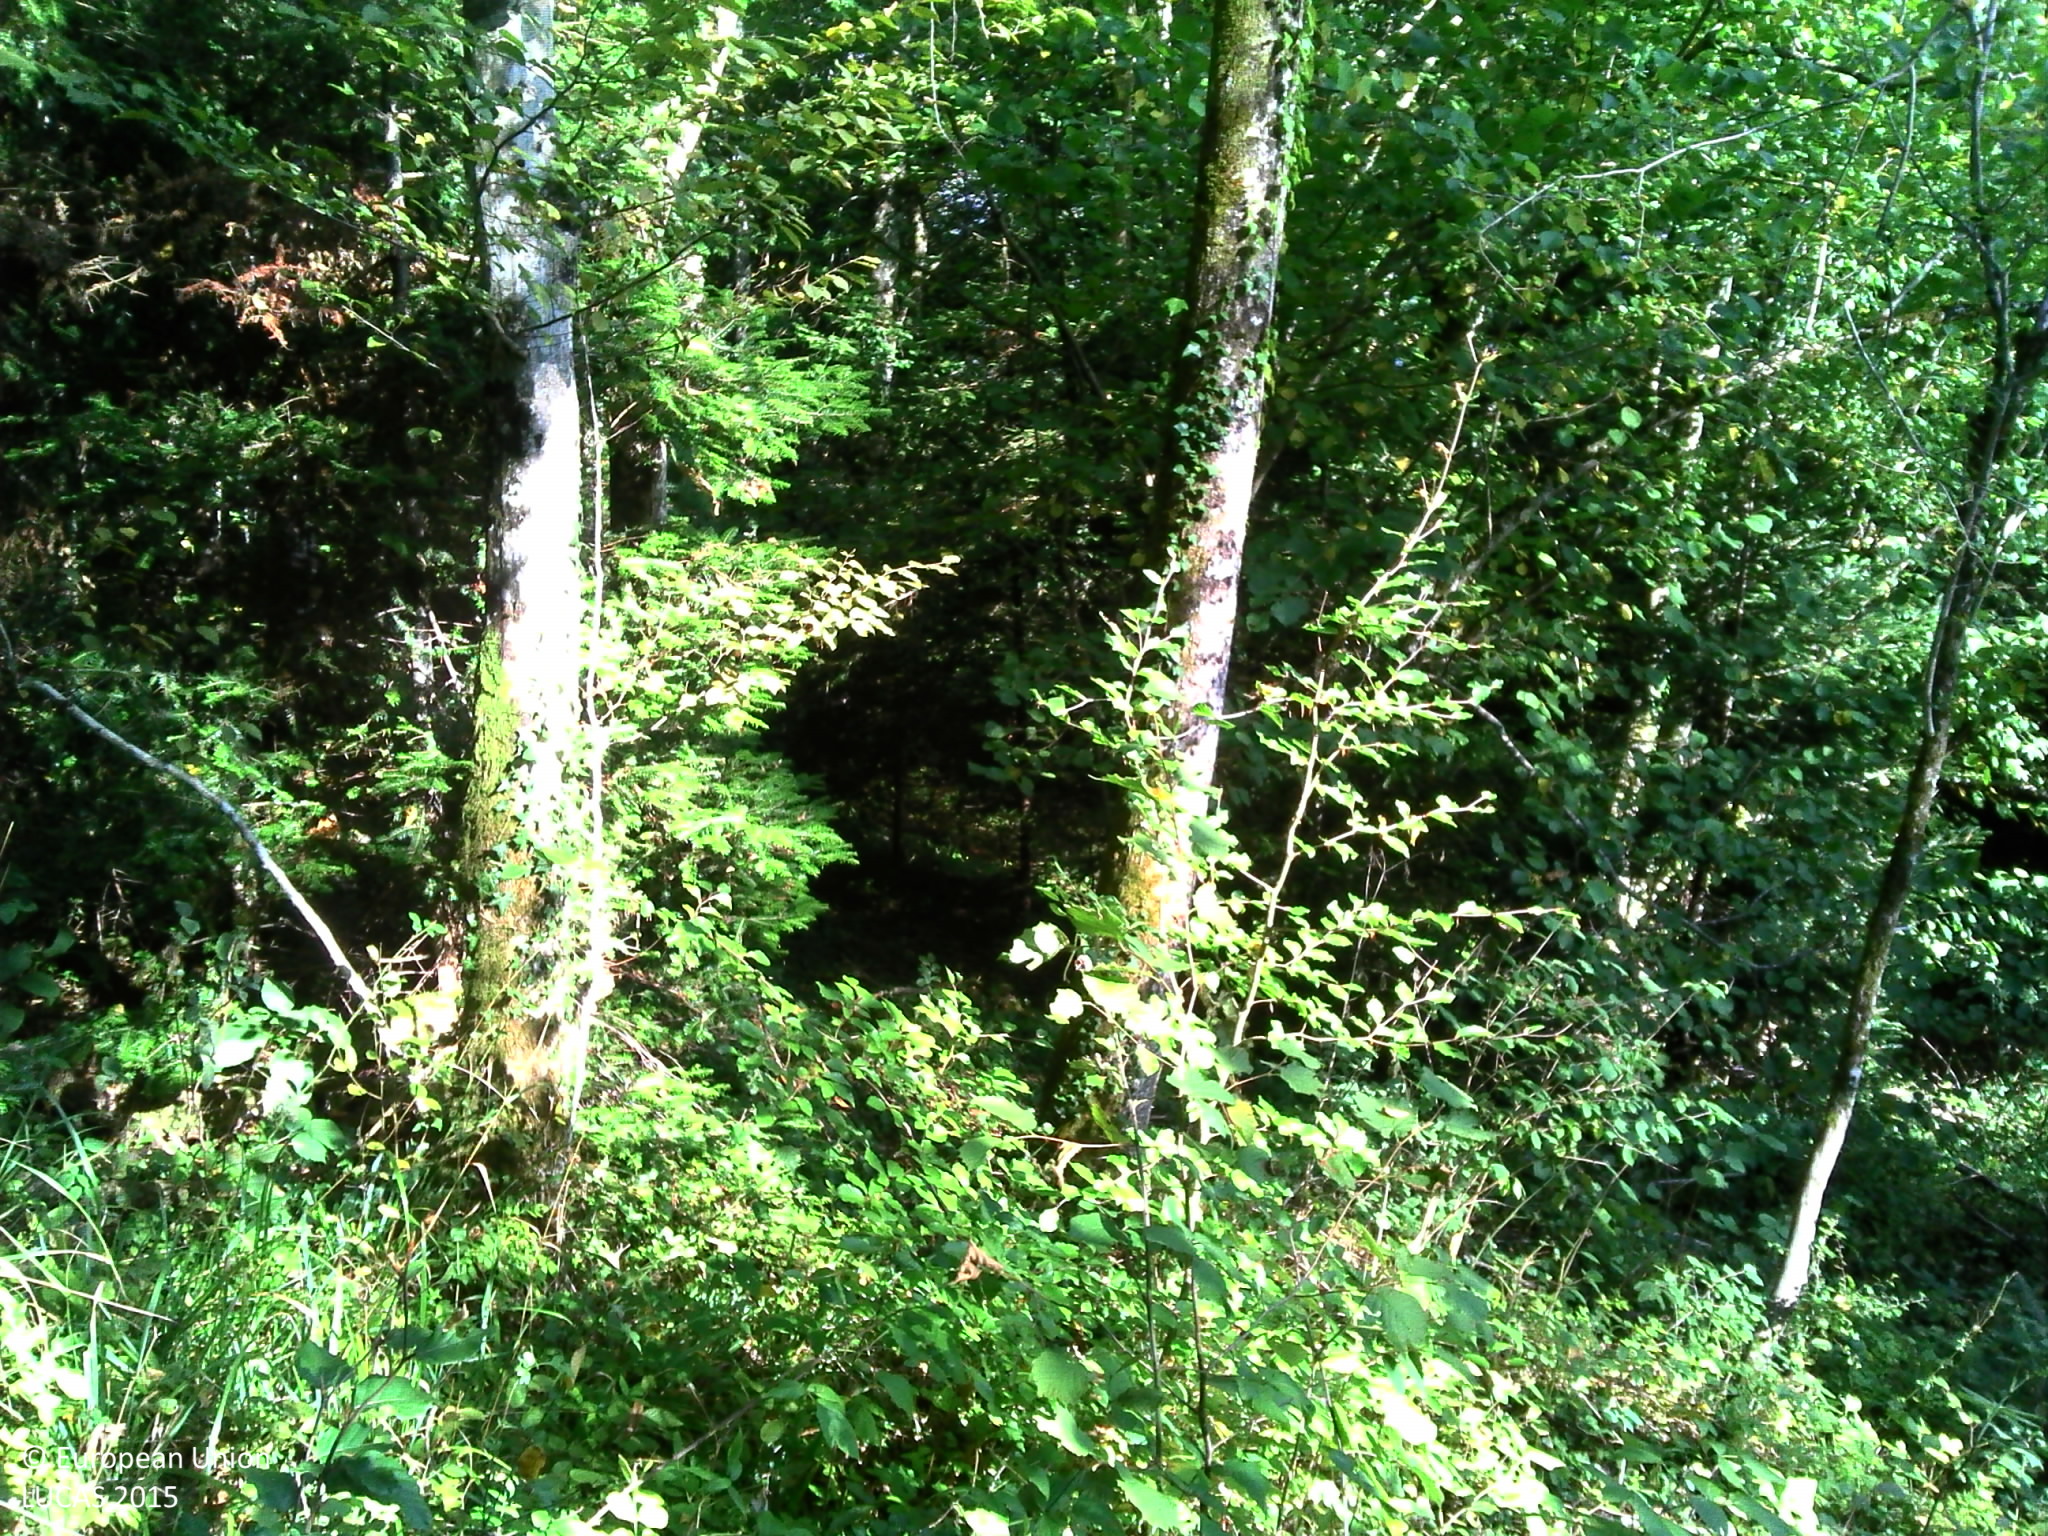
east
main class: Woodland
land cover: Spruce dominated mixed woodland
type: hemiboreal forest and nemoral coniferous forest and mixed broadleaved-coniferous forest
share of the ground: > 75 %
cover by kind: coniferous forest trees 50 %, broadleaved forest trees 30 %, shrubs 10 %, herbaceous plants 10 %
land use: Forestry
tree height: > 5 m
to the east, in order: Spruce dominated mixed woodland; Paved roads, cycling and walking lanes; Spruce dominated mixed woodland; Paved roads, cycling and walking lanes; Spruce dominated mixed woodland
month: September
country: FR
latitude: 47.3175
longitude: 6.9724
